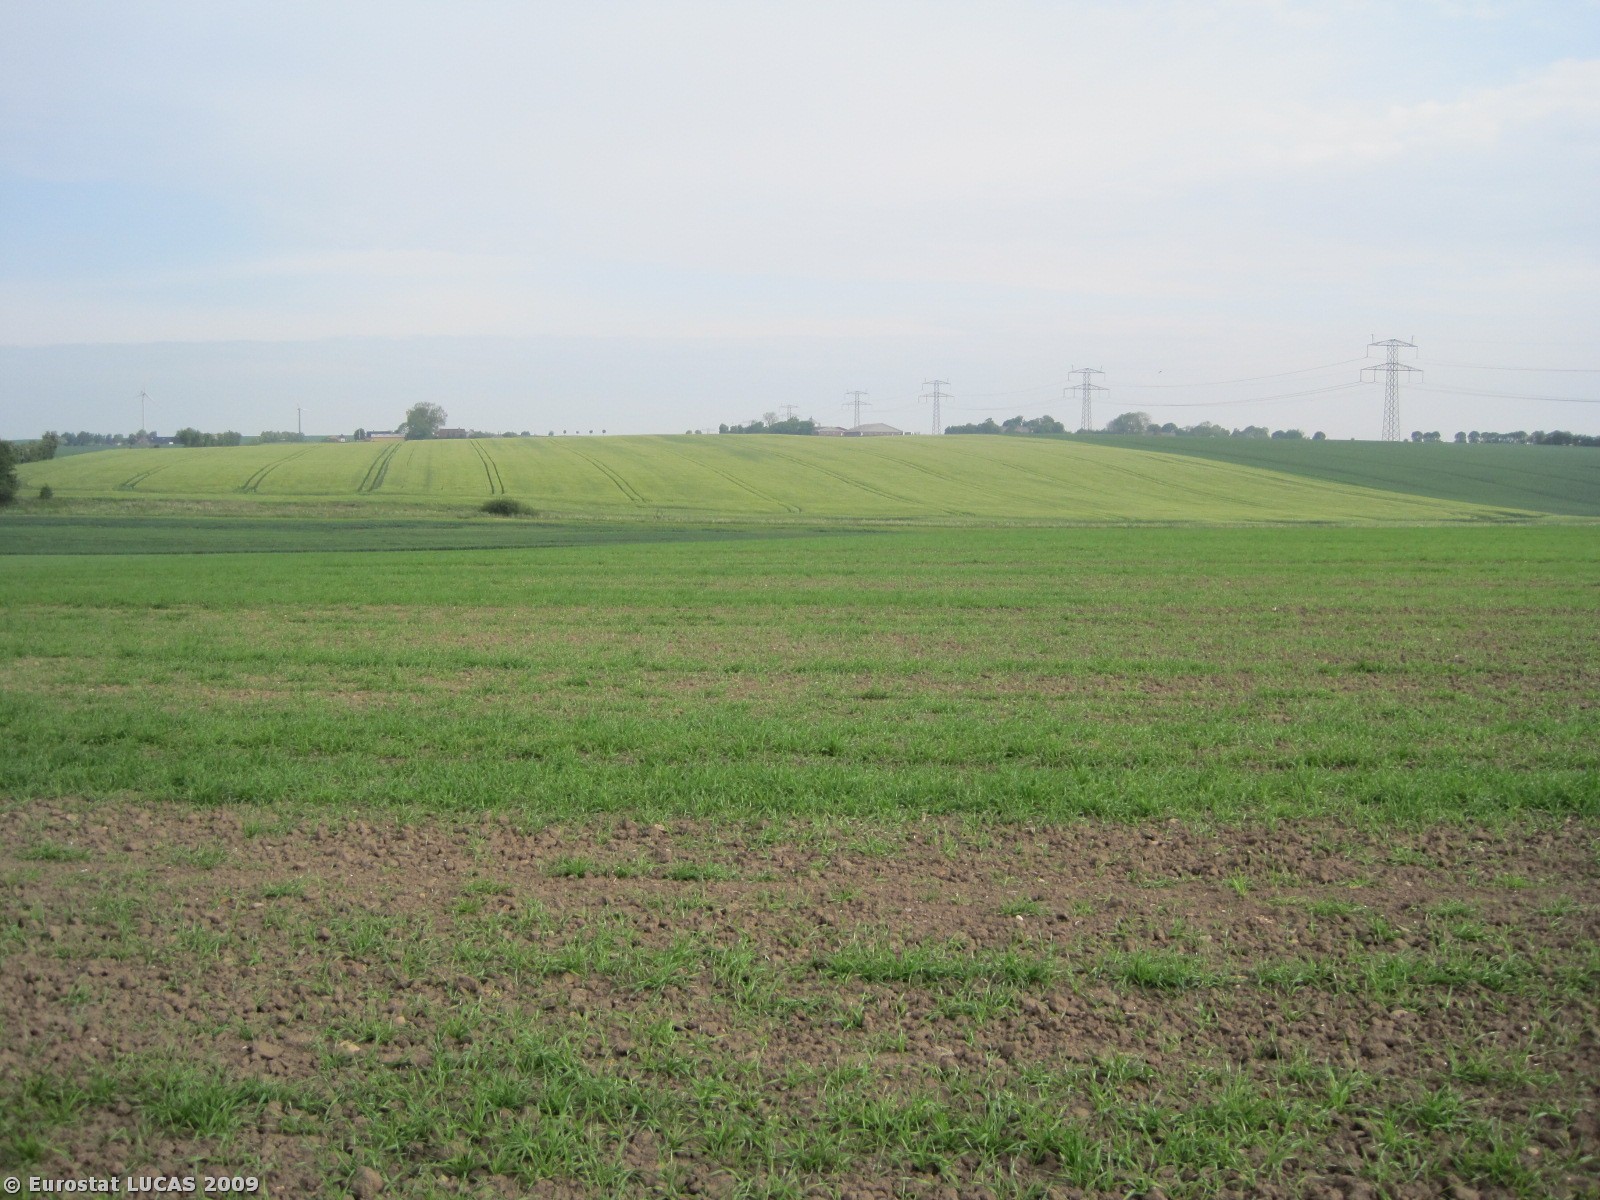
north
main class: Cropland
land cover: Barley
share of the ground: > 75 %
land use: Agriculture (excluding fallow land and kitchen gardens)
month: May
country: DK
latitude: 56.3855
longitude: 10.0162
